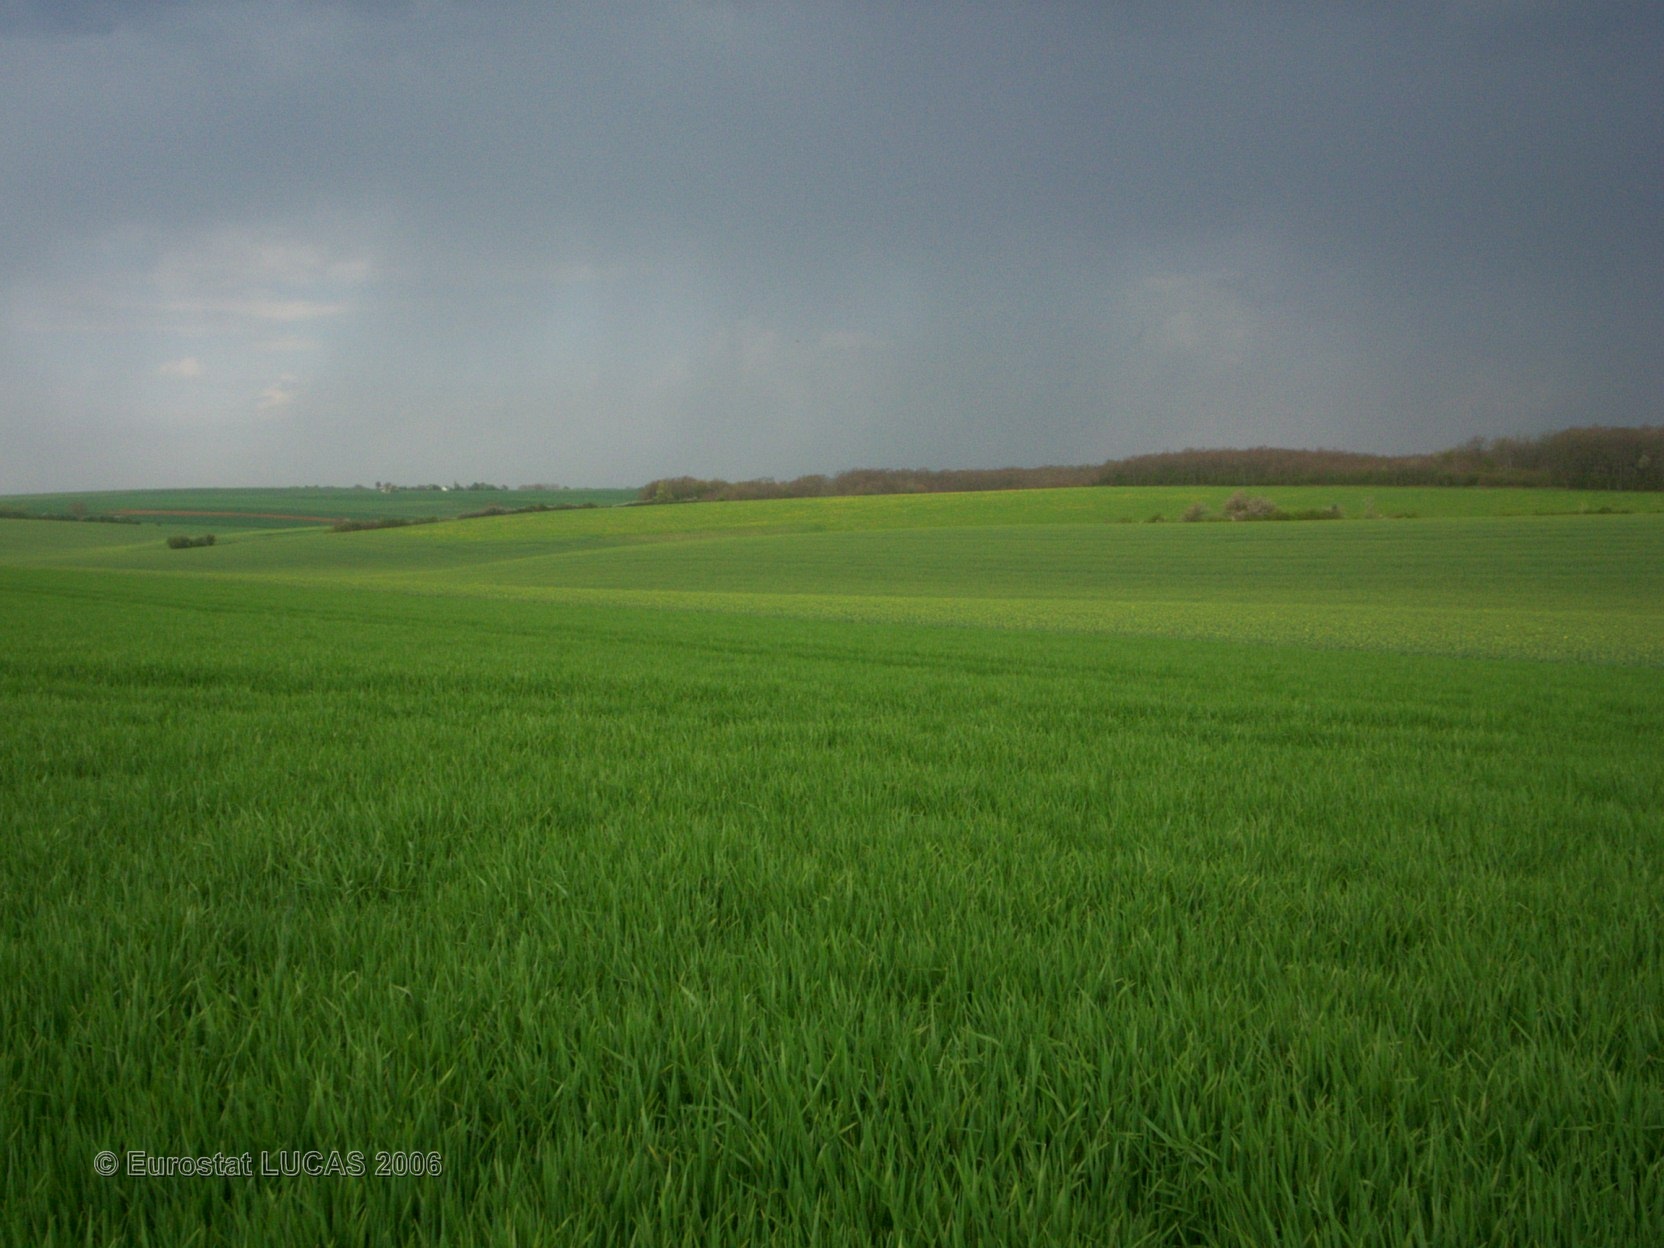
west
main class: Cropland
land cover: Barley
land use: Agriculture (excluding fallow land and kitchen gardens)
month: April
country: FR
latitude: 47.3910
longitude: 3.0662
